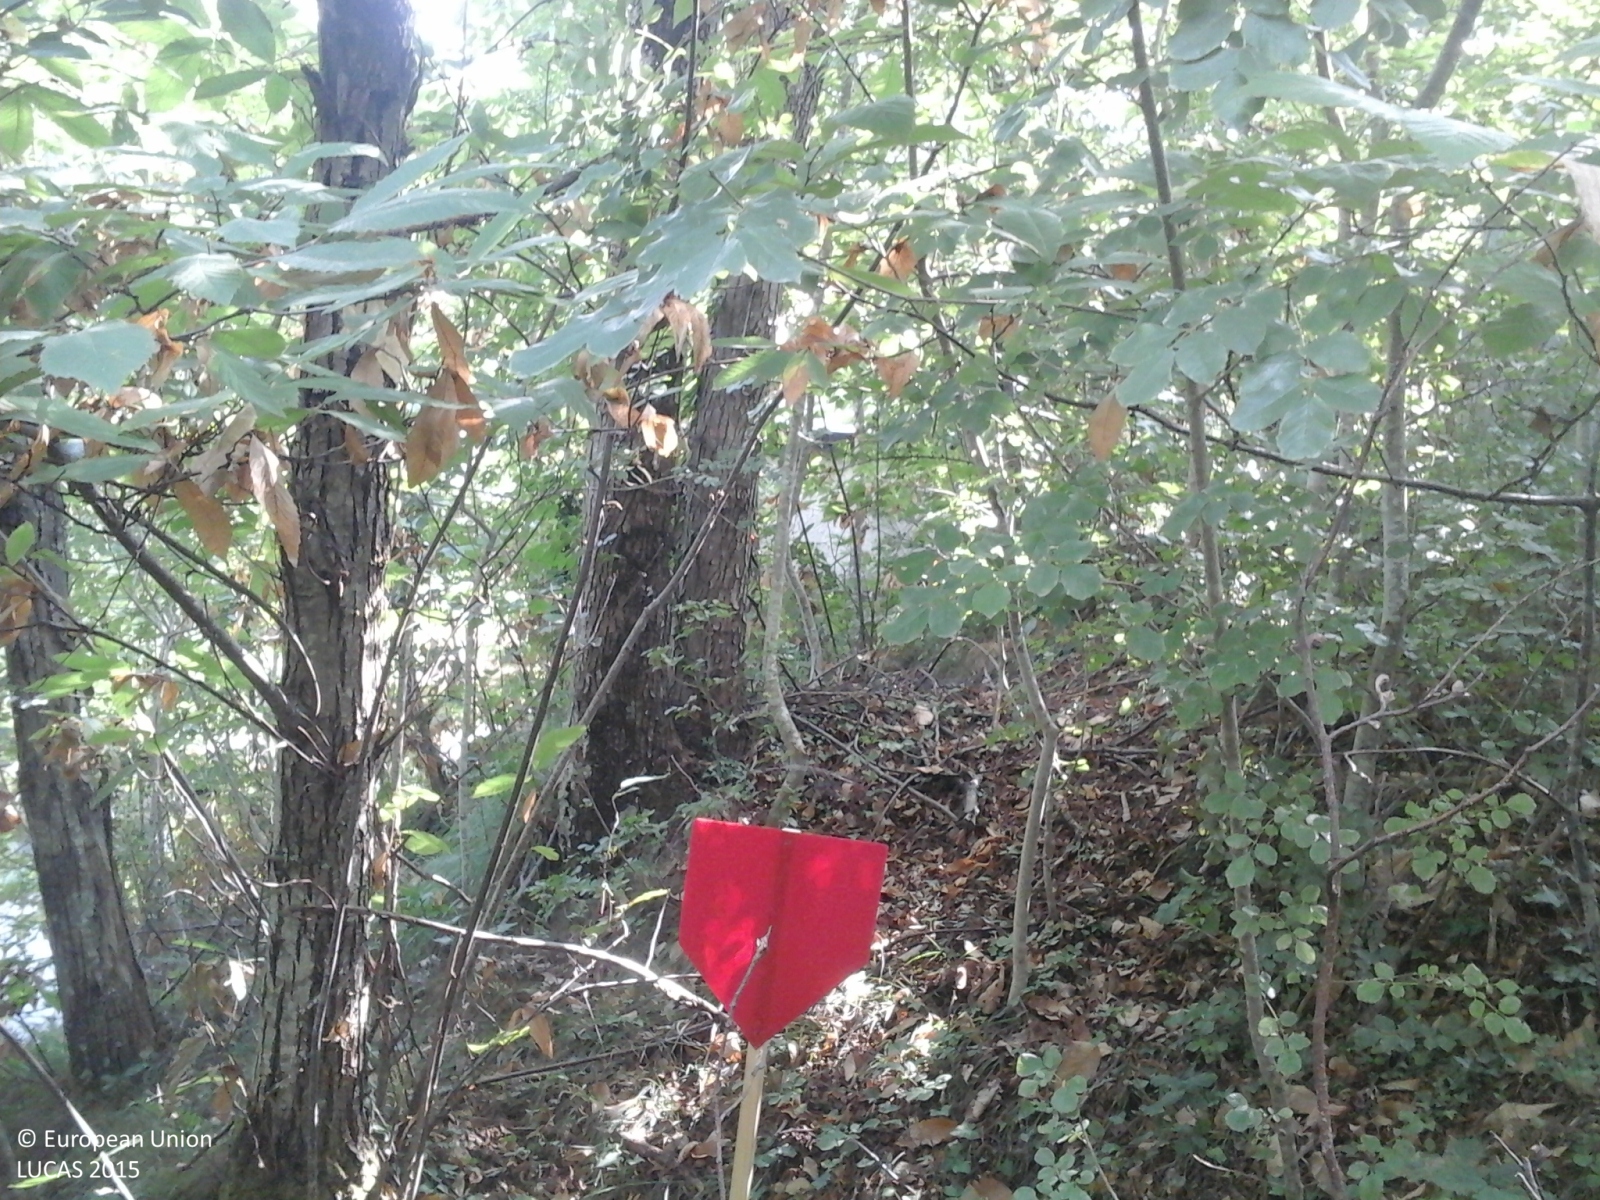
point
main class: Woodland
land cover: Broadleaved woodland
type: mesophytic deciduous forest
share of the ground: > 75 %
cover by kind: broadleaved forest trees 100 %
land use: Forestry
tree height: > 5 m
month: September
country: IT
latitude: 44.4552
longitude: 9.1348
